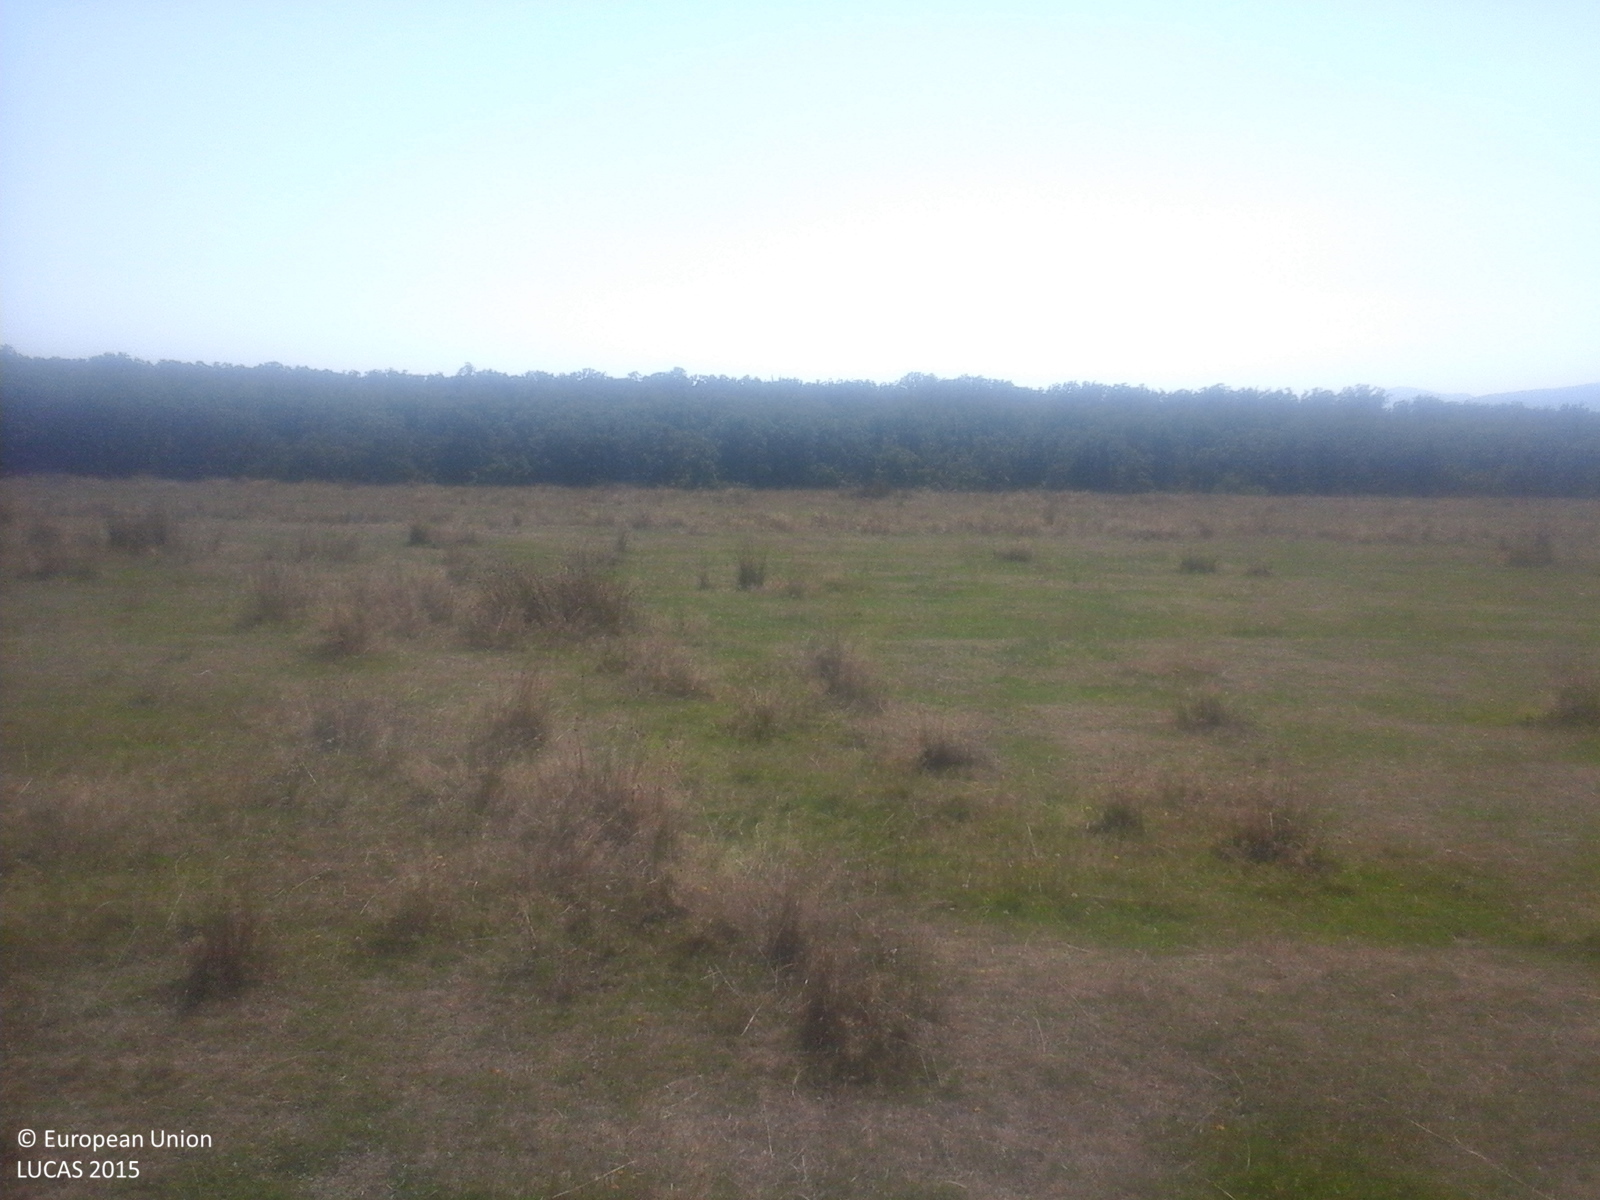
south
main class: Grassland
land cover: Grassland without tree/shrub cover
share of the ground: > 75 %
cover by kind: herbaceous plants 100 %
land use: Agriculture (excluding fallow land and kitchen gardens)
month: September
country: RO
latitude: 46.6881
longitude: 22.3543
